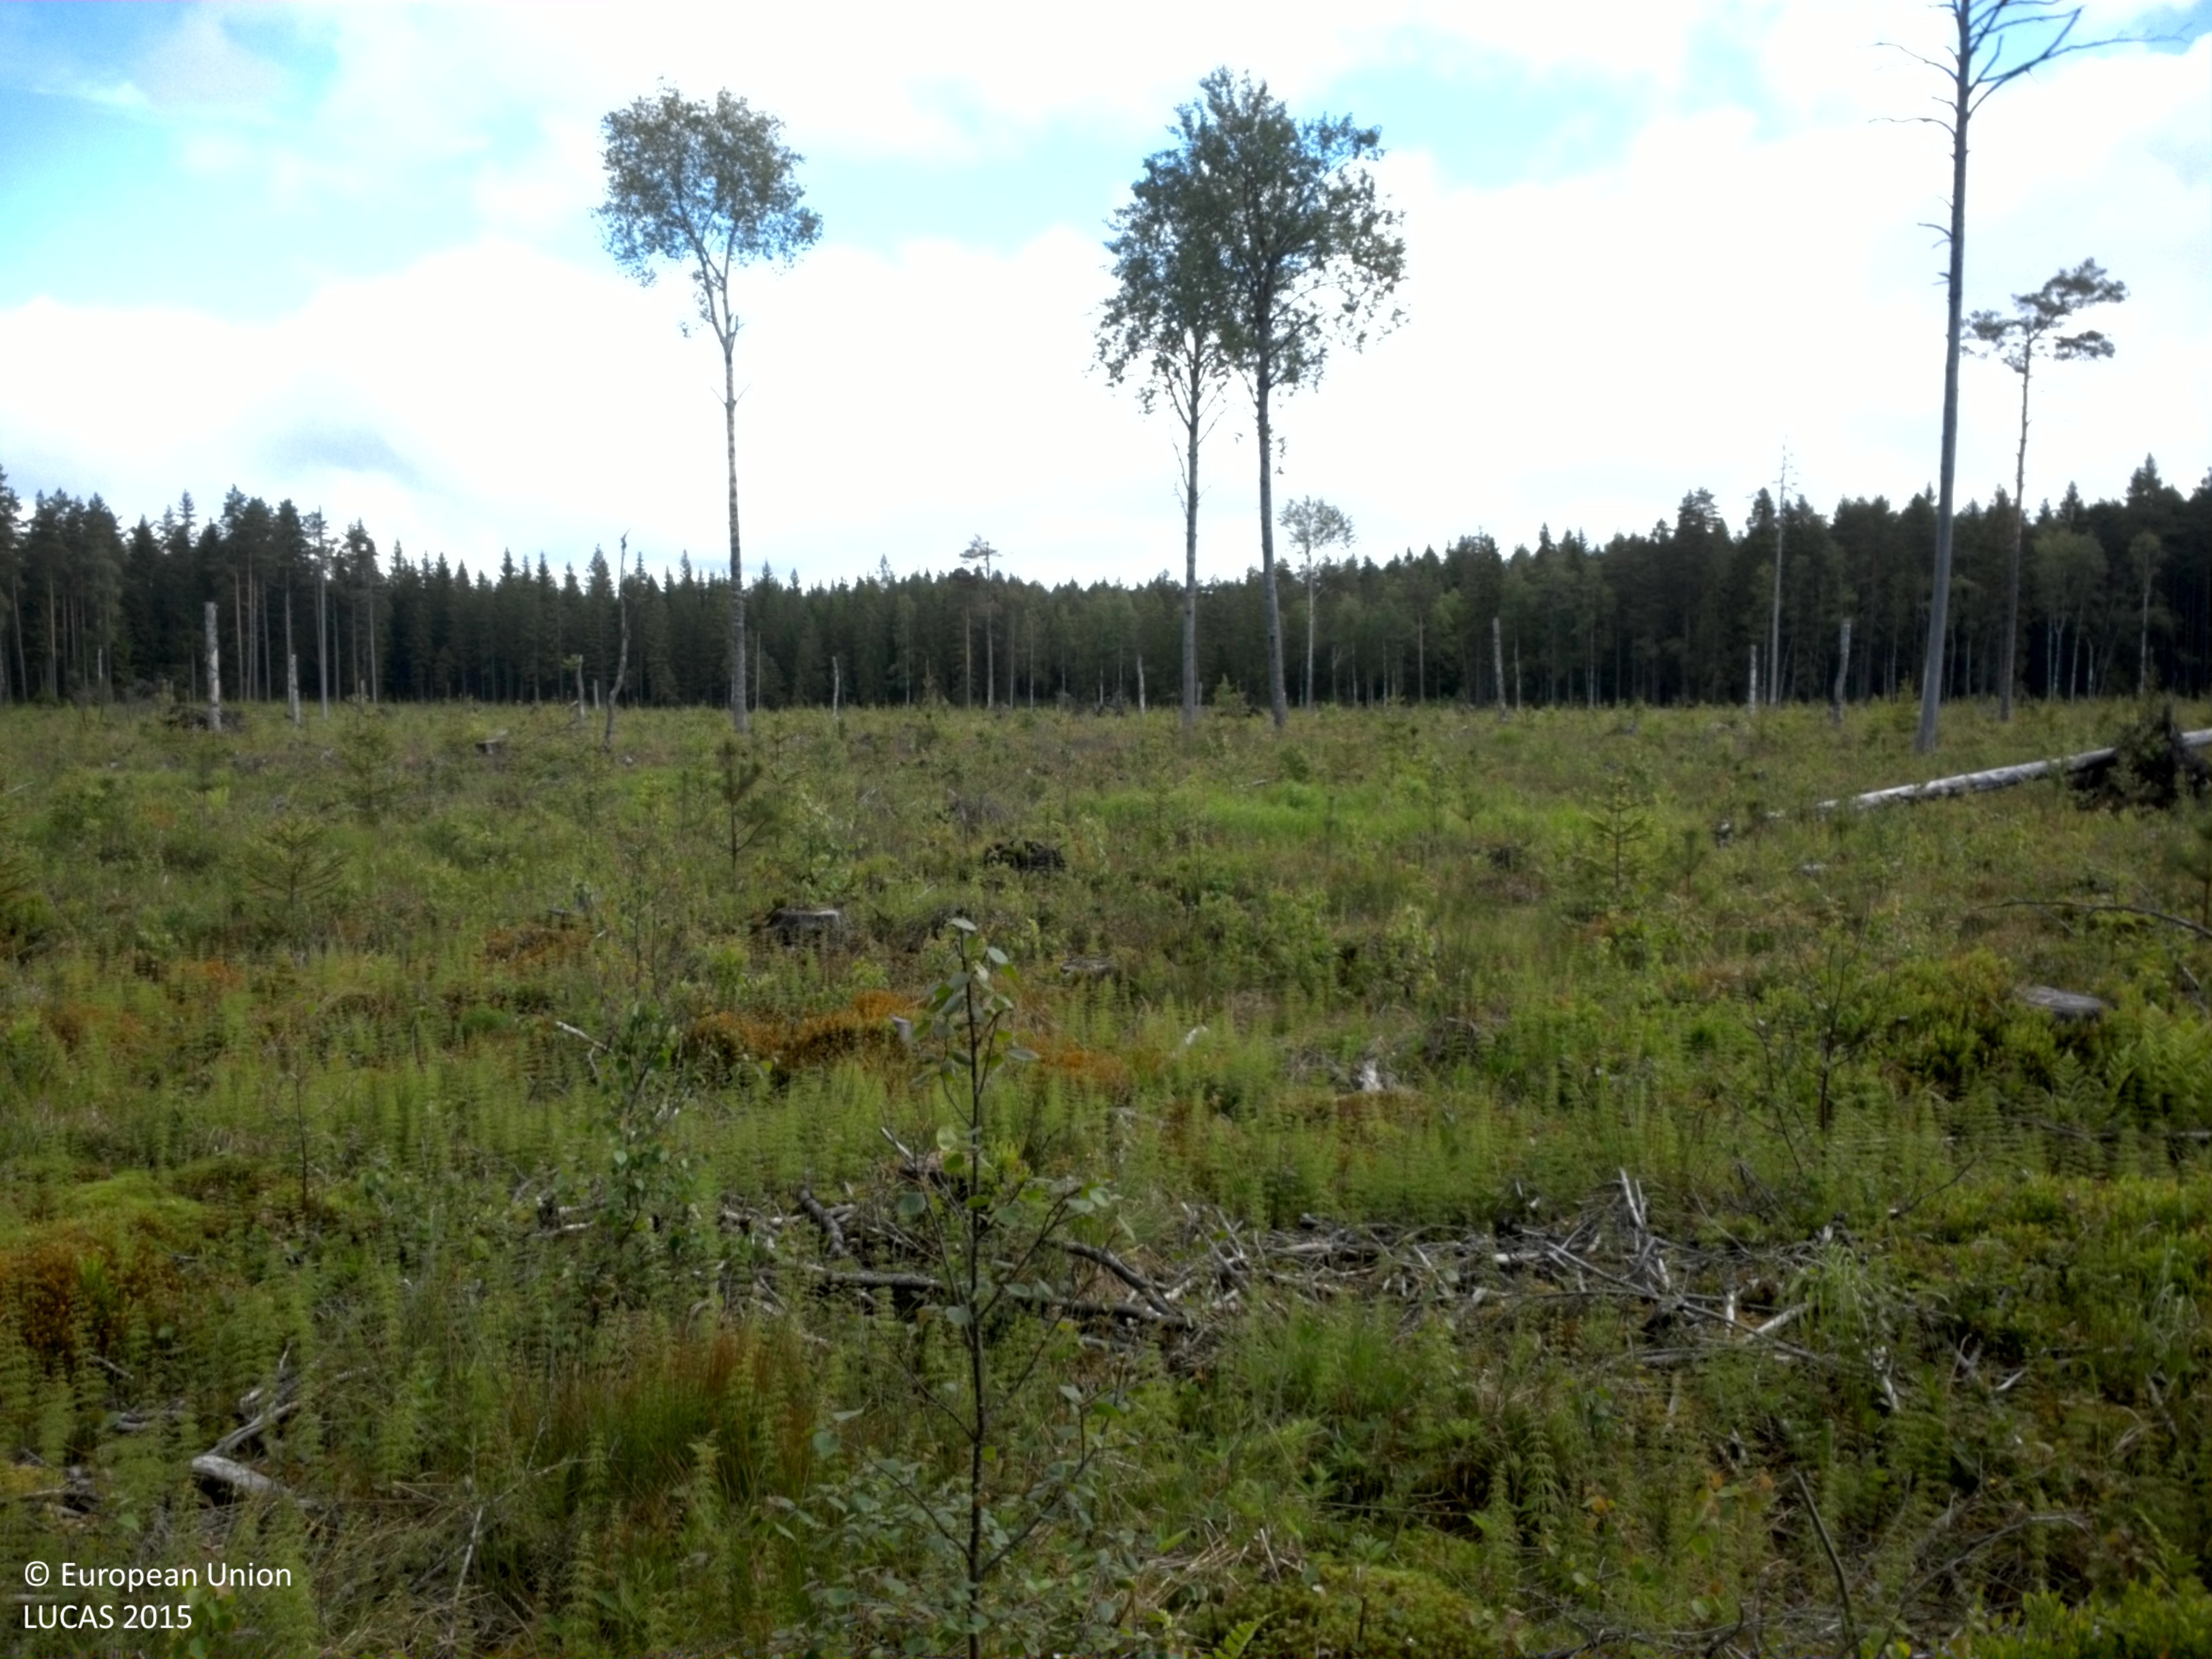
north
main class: Woodland
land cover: Spruce dominated mixed woodland
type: boreal forest
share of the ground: 10 - 25 %
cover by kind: herbaceous plants 40 %, lichens and mosses 40 %, coniferous forest trees 15 %, broadleaved forest trees 5 %
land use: Forestry
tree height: < 5 m
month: June
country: SE
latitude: 59.9261
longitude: 17.1665
